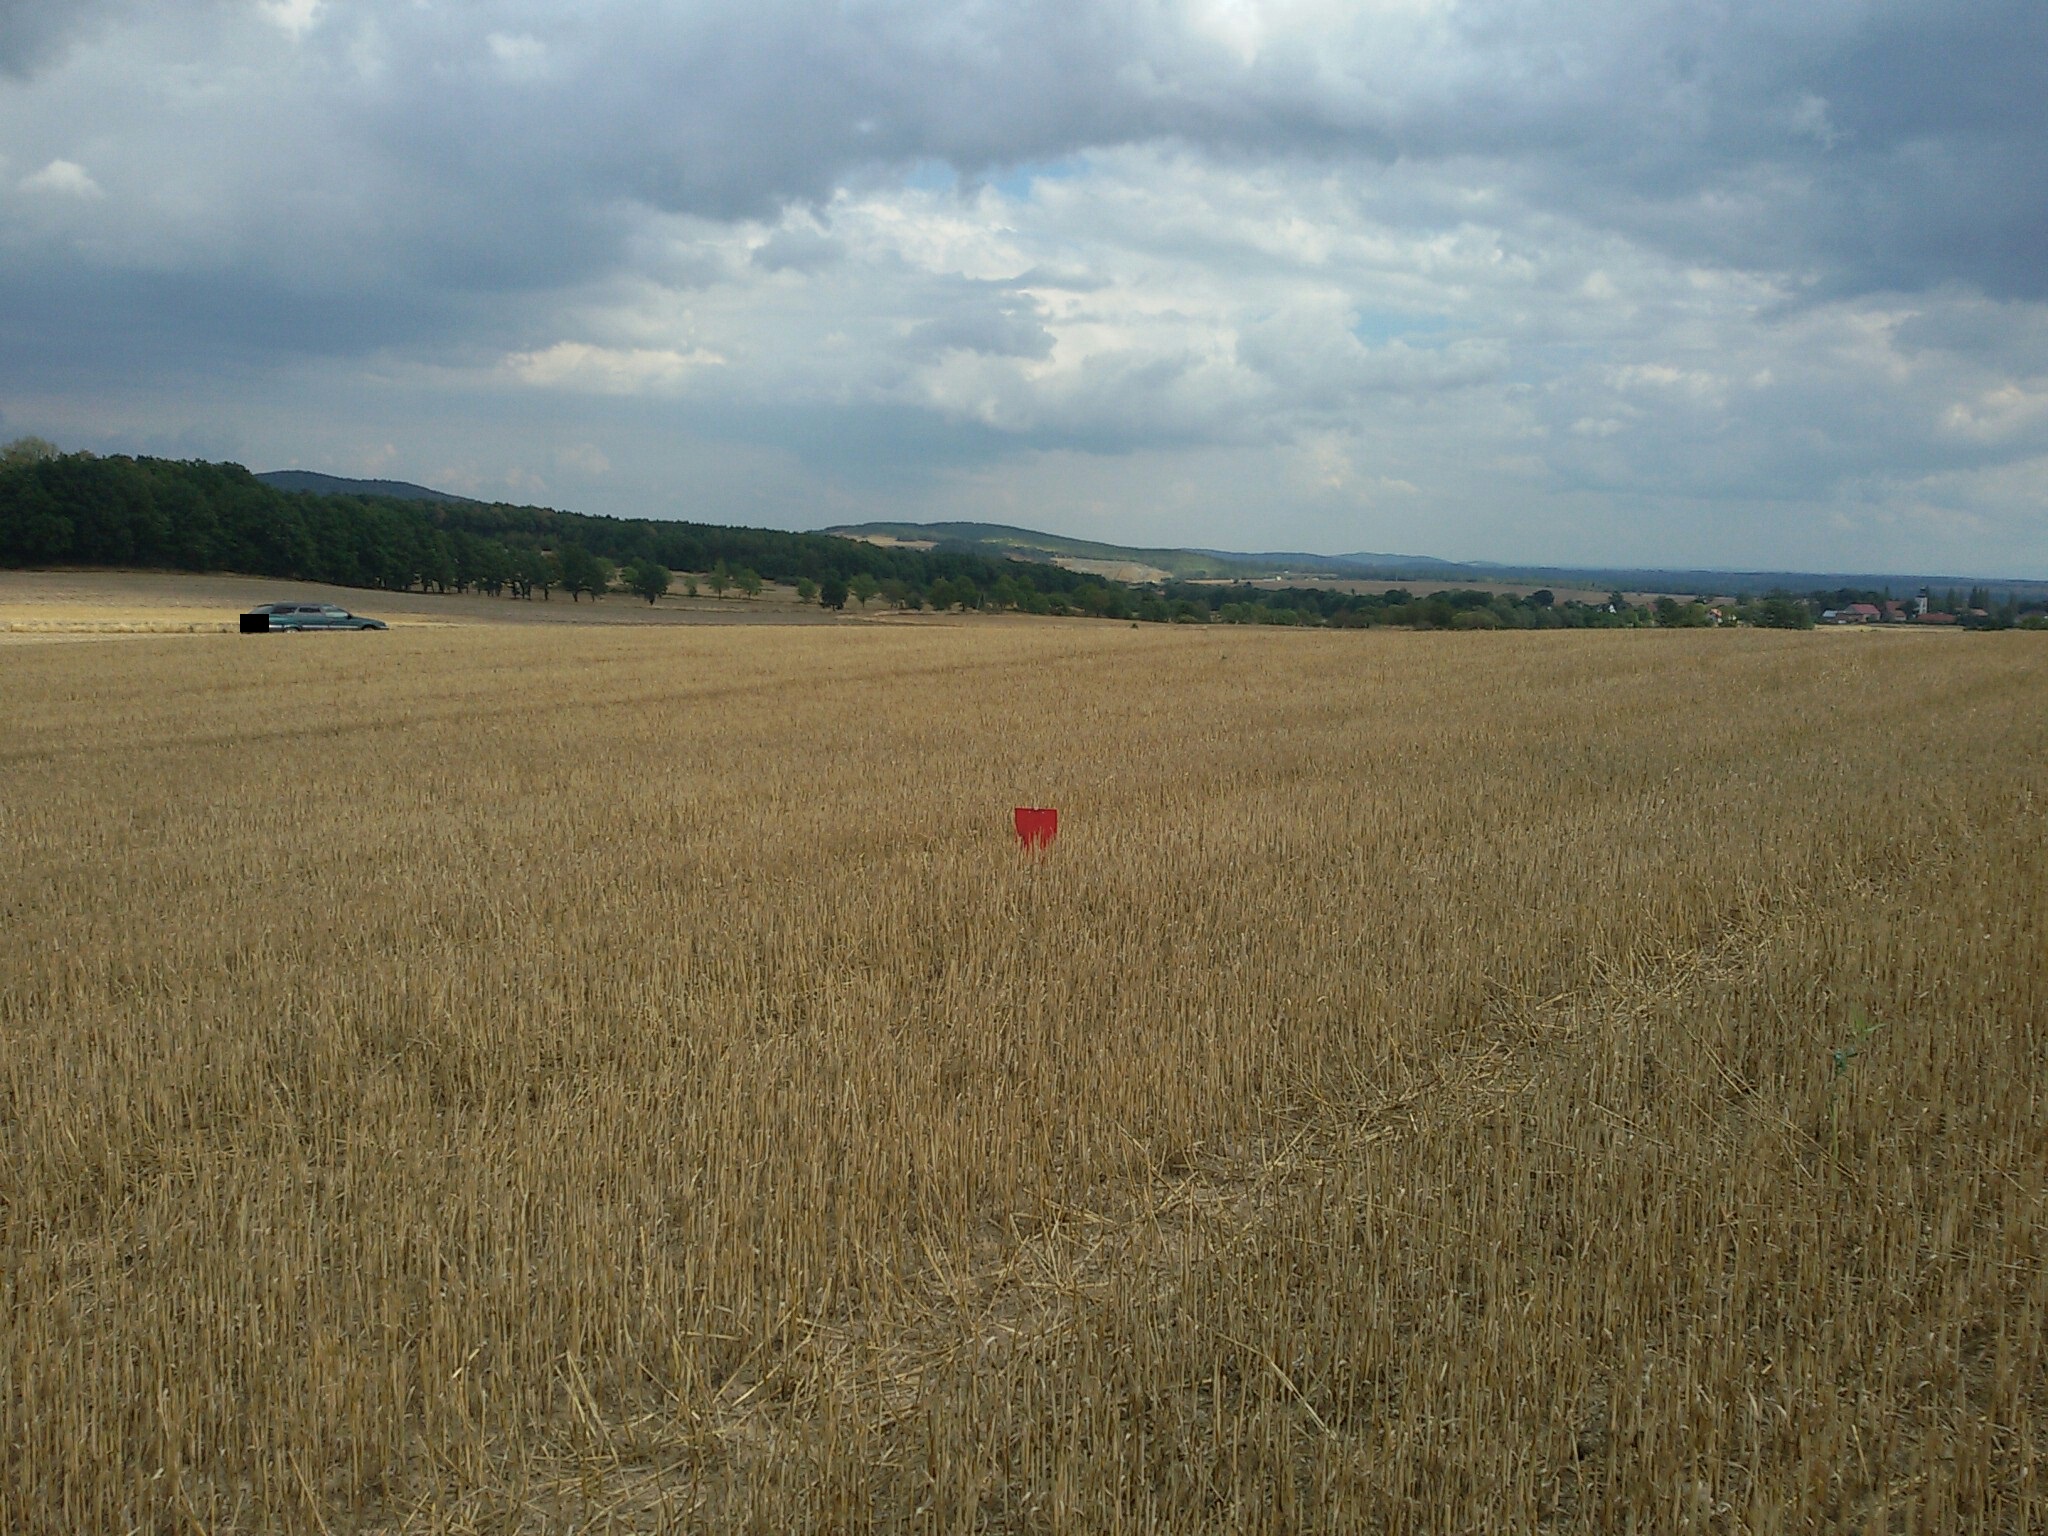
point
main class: Cropland
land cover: Common wheat
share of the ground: > 75 %
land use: Agriculture (excluding fallow land and kitchen gardens)
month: September
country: PL
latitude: 50.5458
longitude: 16.7119
